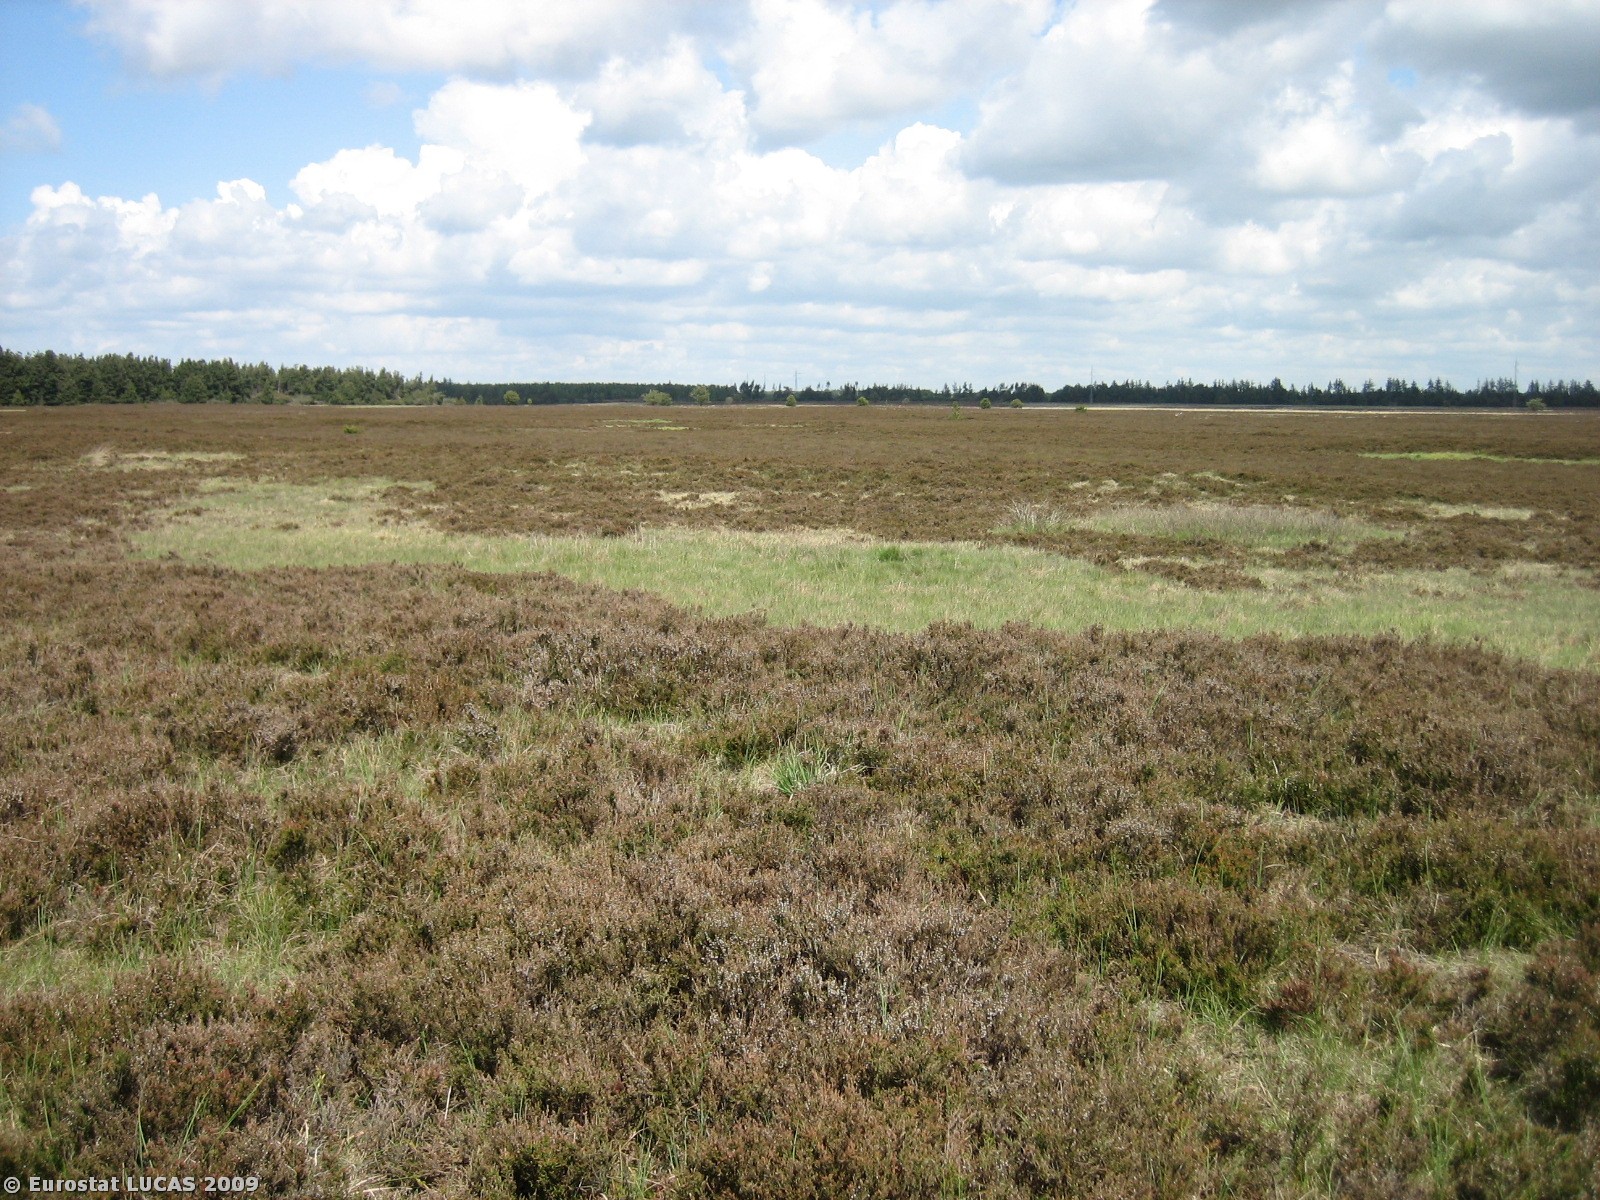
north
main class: Shrubland
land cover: Shrubland with sparse tree cover
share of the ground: > 75 %
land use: Nature reserves
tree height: > 5 m
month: May
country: DK
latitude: 56.2374
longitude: 8.9525
